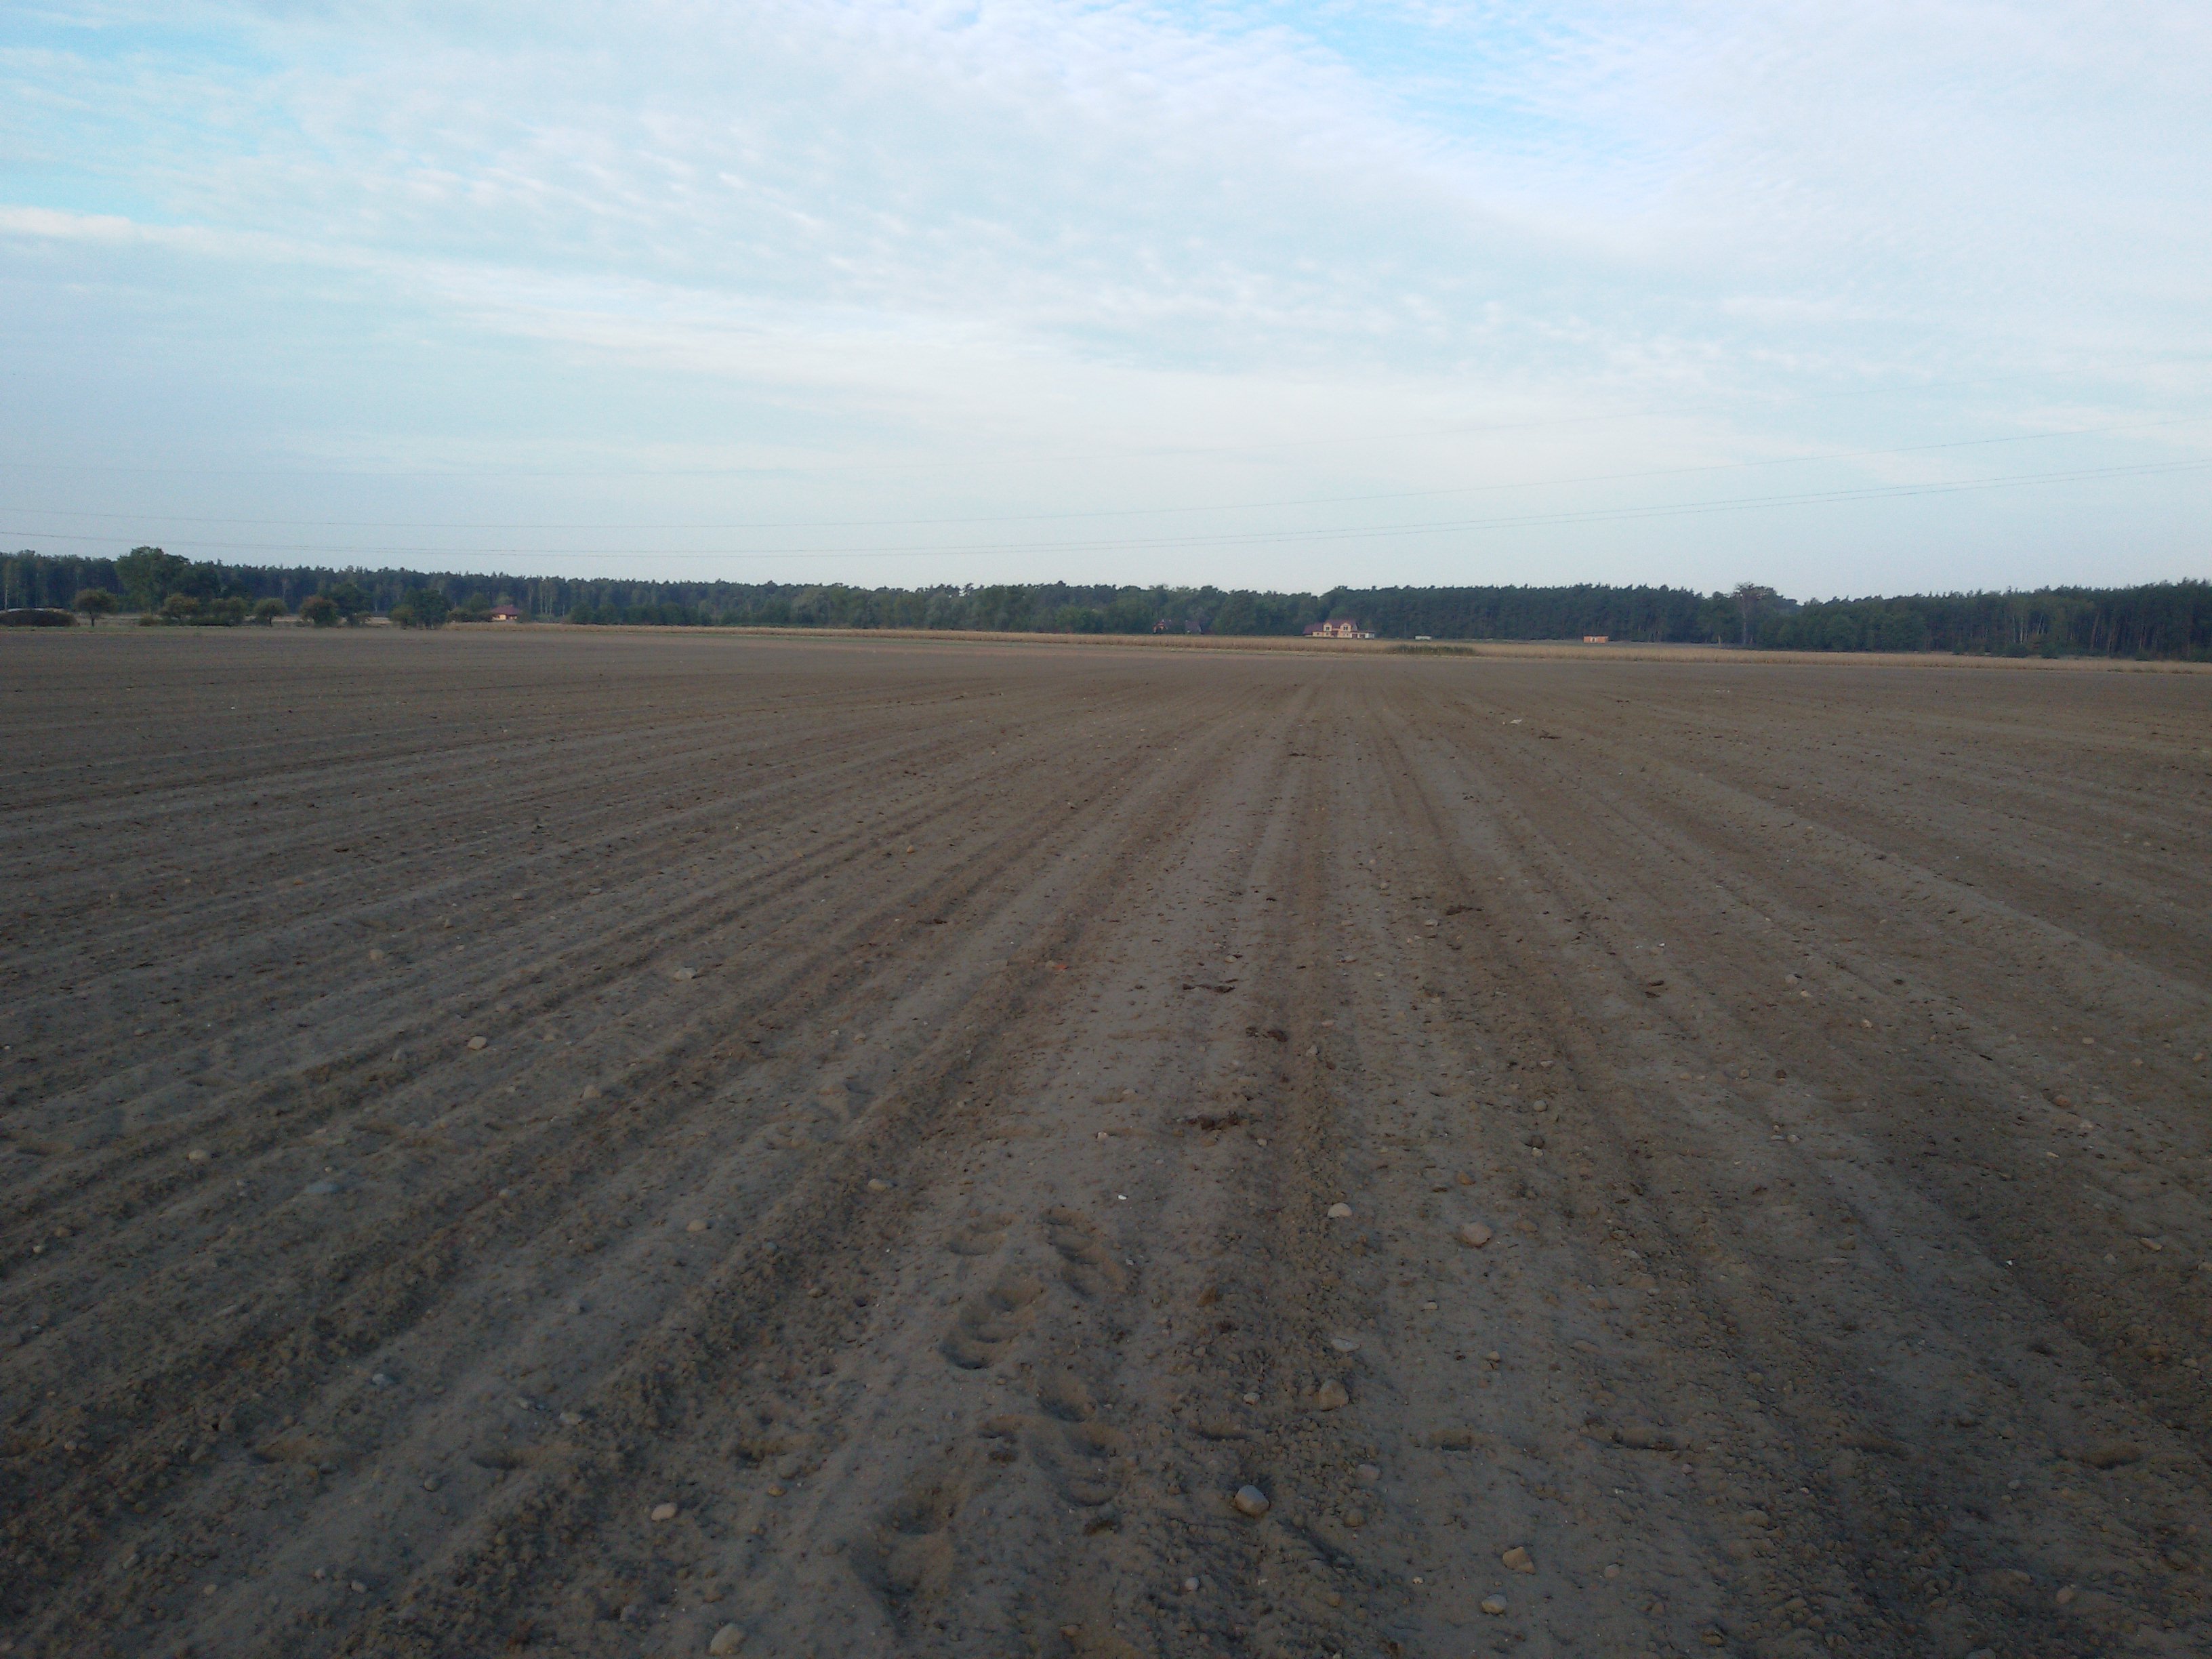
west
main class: Cropland
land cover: Rye
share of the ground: < 10 %
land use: Agriculture (excluding fallow land and kitchen gardens)
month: October
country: PL
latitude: 51.6608
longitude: 17.3704
